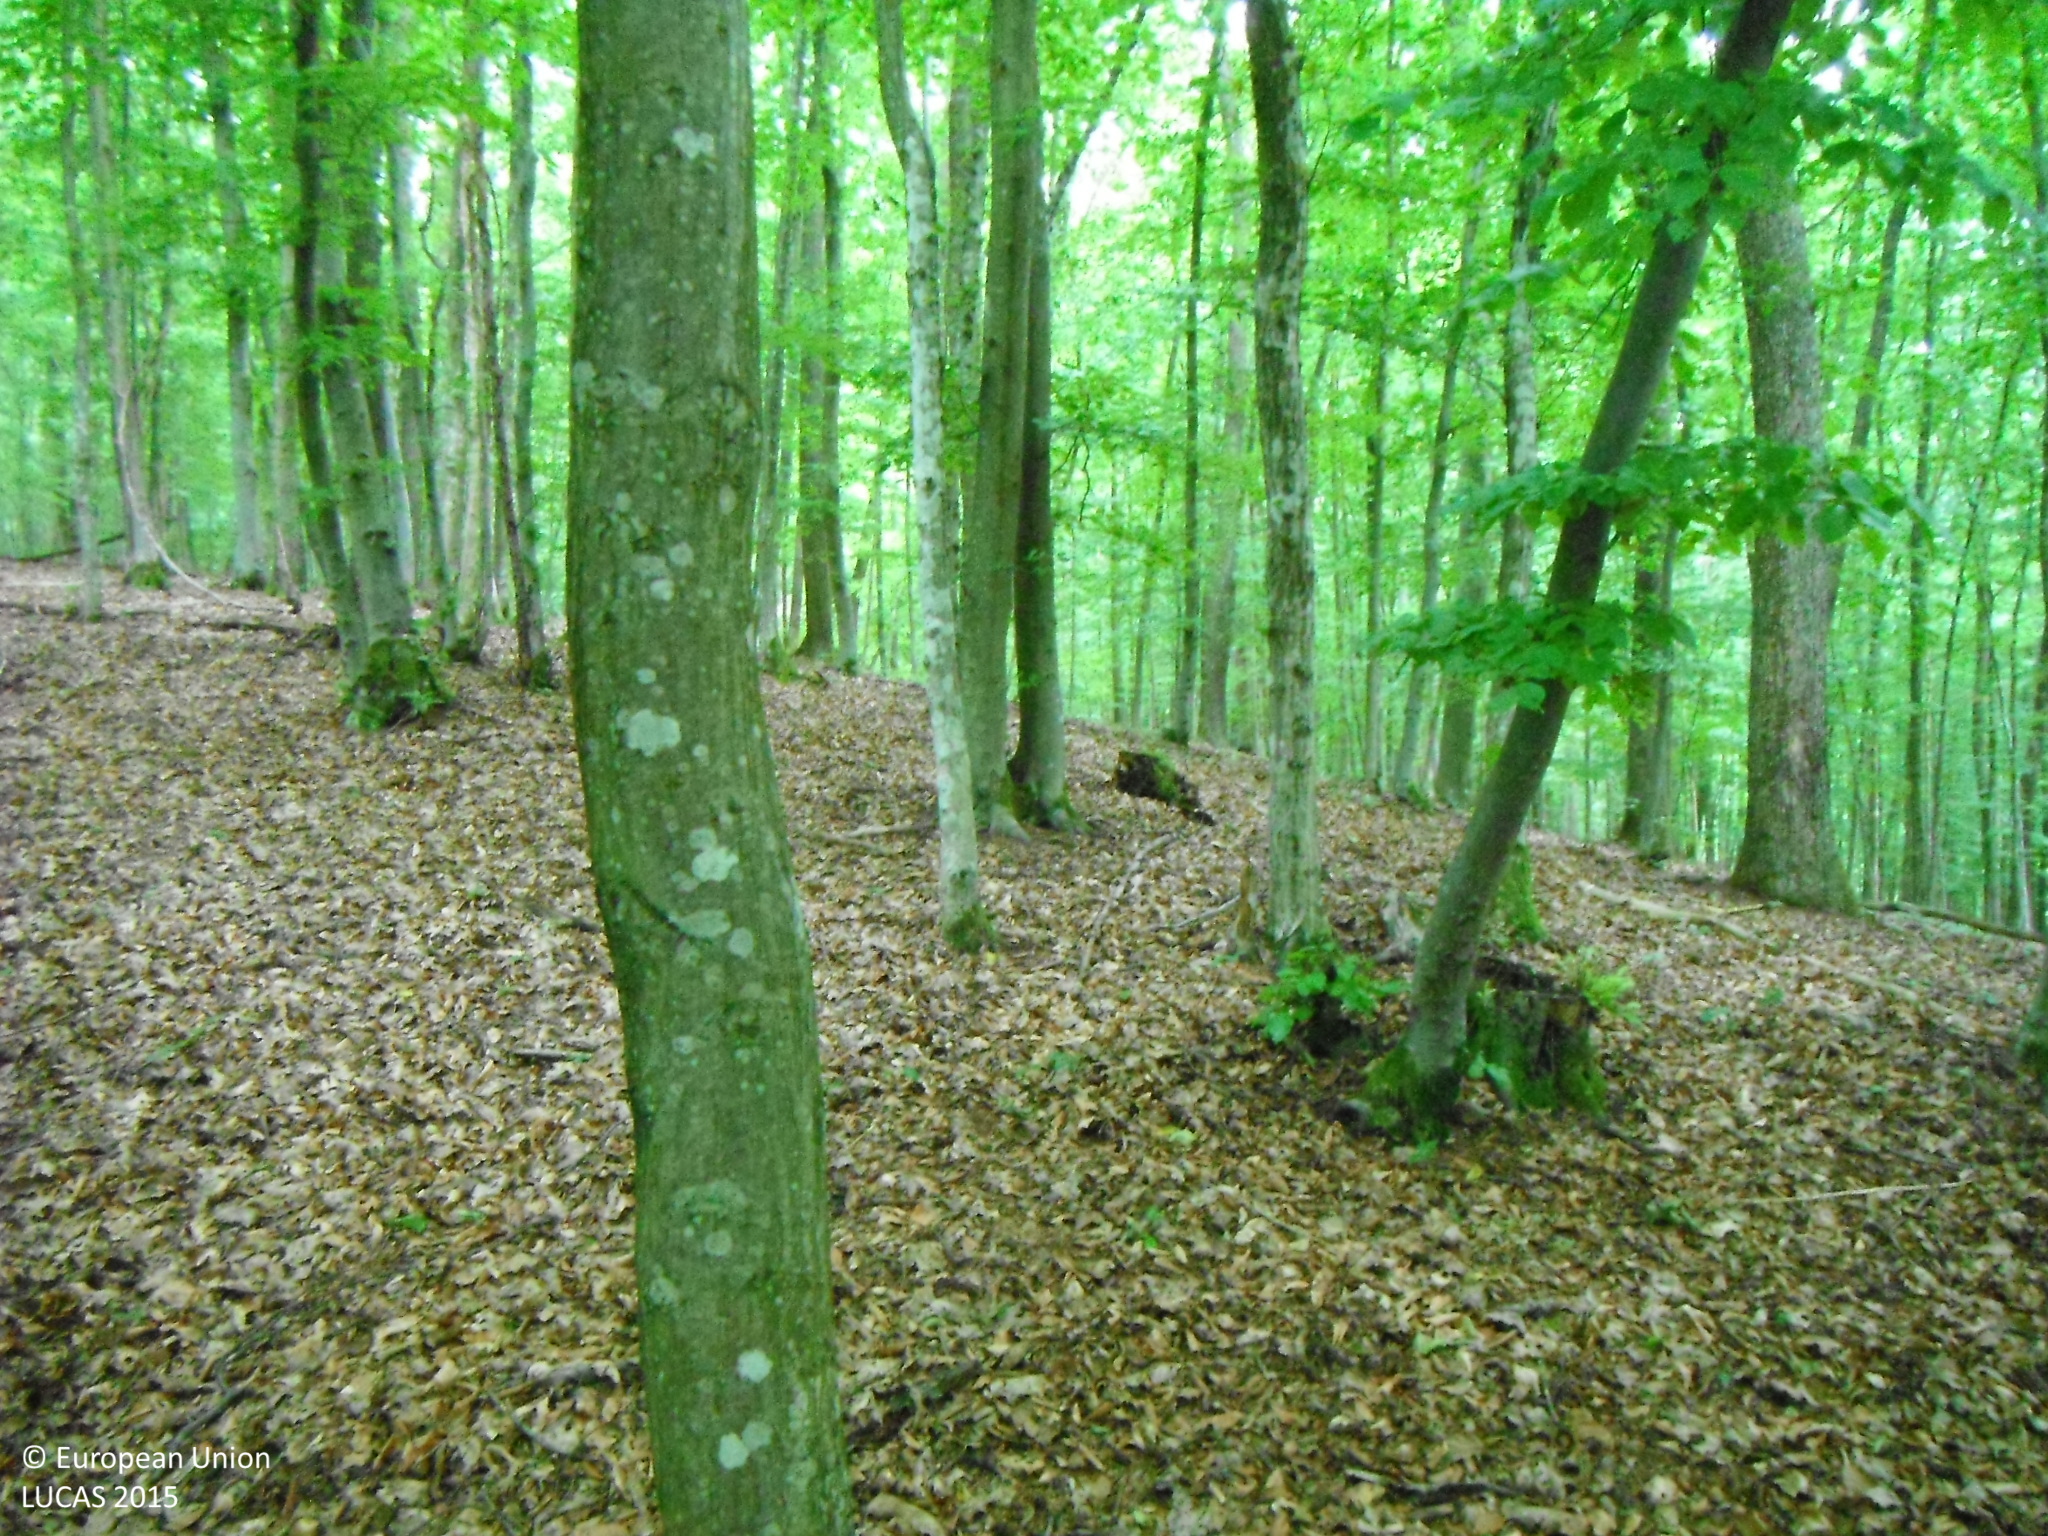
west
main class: Woodland
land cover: Broadleaved woodland
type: mesophytic deciduous forest
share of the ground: > 75 %
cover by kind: broadleaved forest trees 95 %, unconsolidated bare surface 5 %
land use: Forestry
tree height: > 5 m
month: June
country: SK
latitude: 48.5338
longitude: 20.1476
